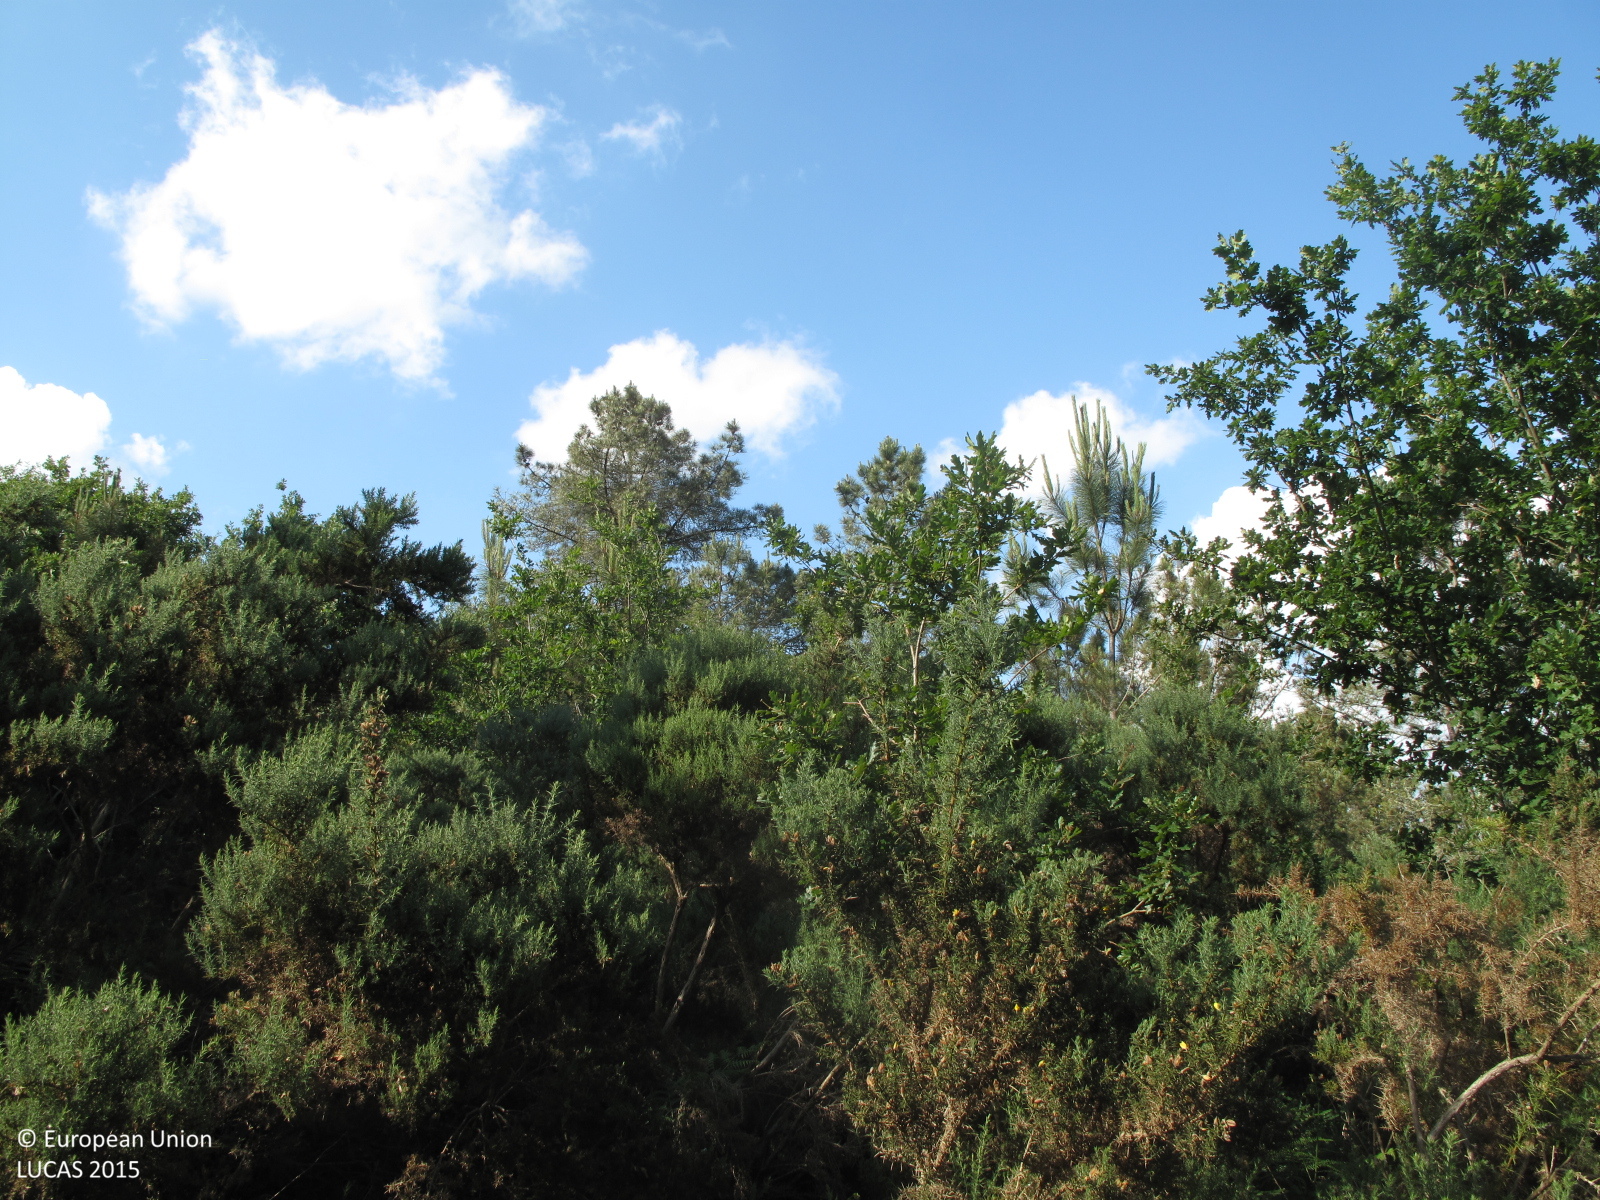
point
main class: Woodland
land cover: Other mixed woodland
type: acidophilous oak and oak-birch forest
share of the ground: 50 - 75 %
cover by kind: shrubs 40 %, broadleaved forest trees 30 %, coniferous forest trees 20 %, herbaceous plants 10 %
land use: Semi-natural and natural areas not in use
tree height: > 5 m
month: June
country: ES
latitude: 42.9286
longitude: -8.4950
